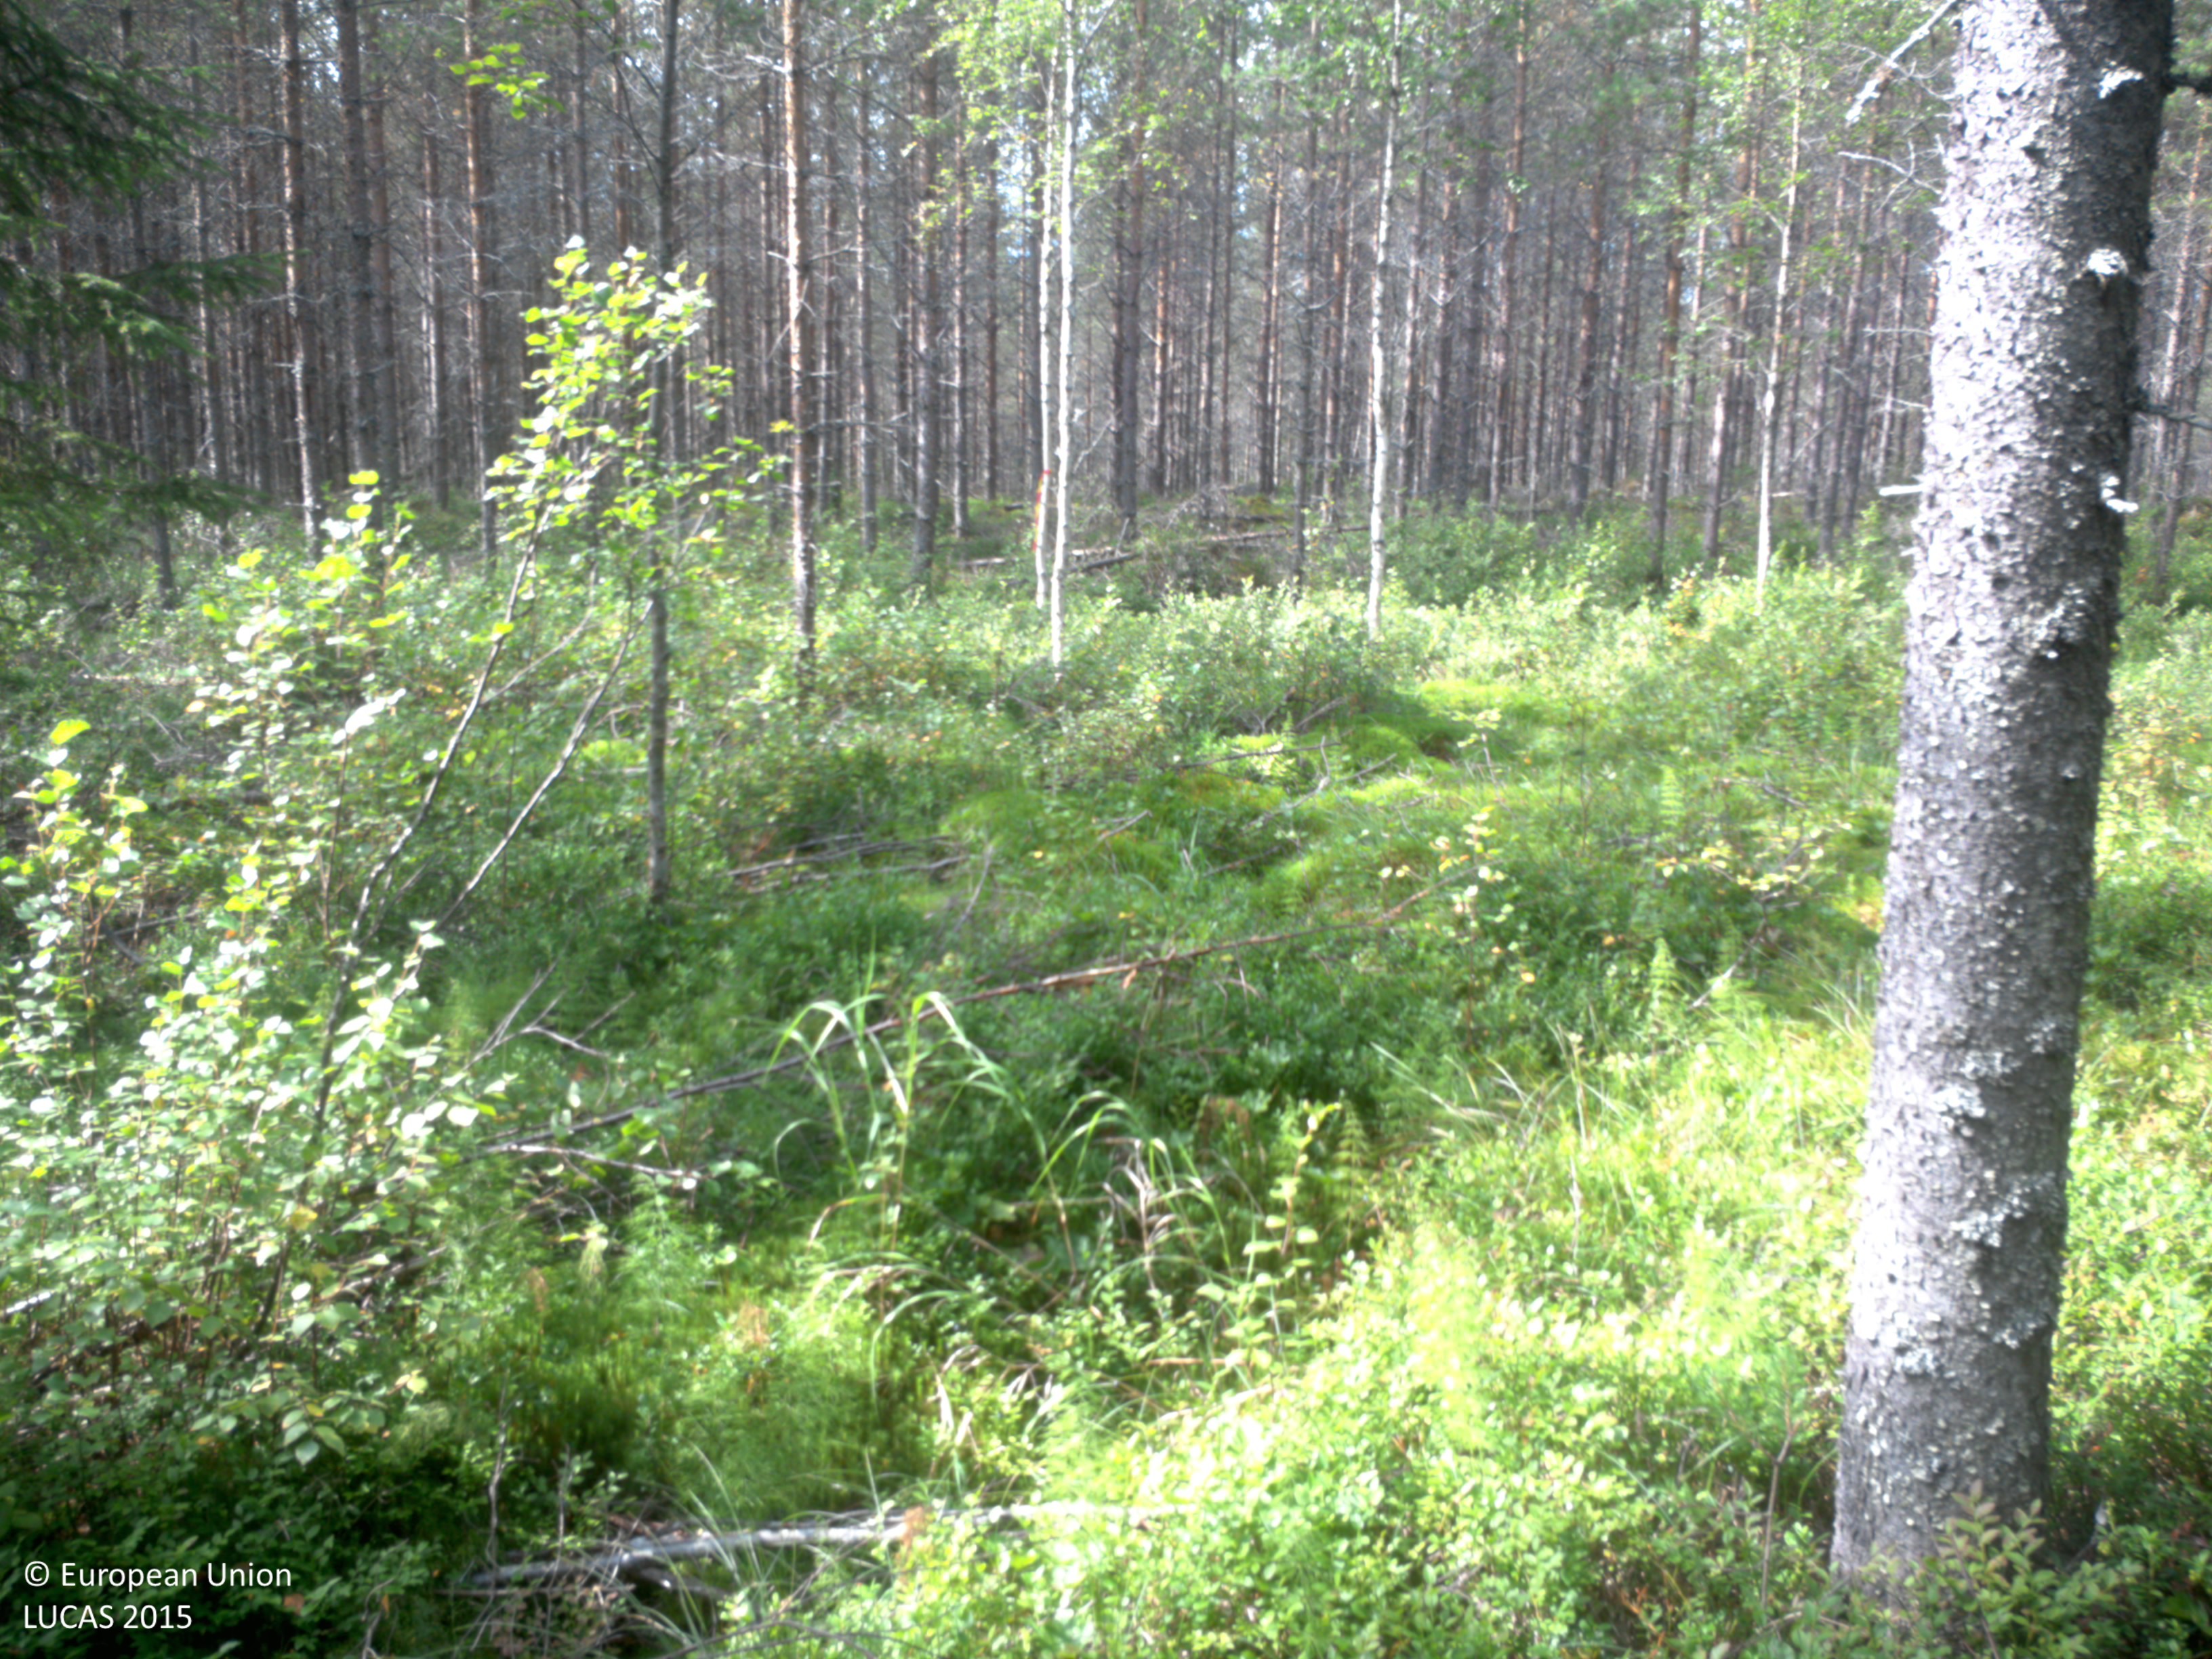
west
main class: Woodland
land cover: Other mixed woodland
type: boreal forest
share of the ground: 50 - 75 %
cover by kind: coniferous forest trees 40 %, shrubs 35 %, broadleaved forest trees 25 %
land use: Forestry
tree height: > 5 m
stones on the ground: < 10 %
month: August
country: SE
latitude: 63.5844
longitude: 19.5091
